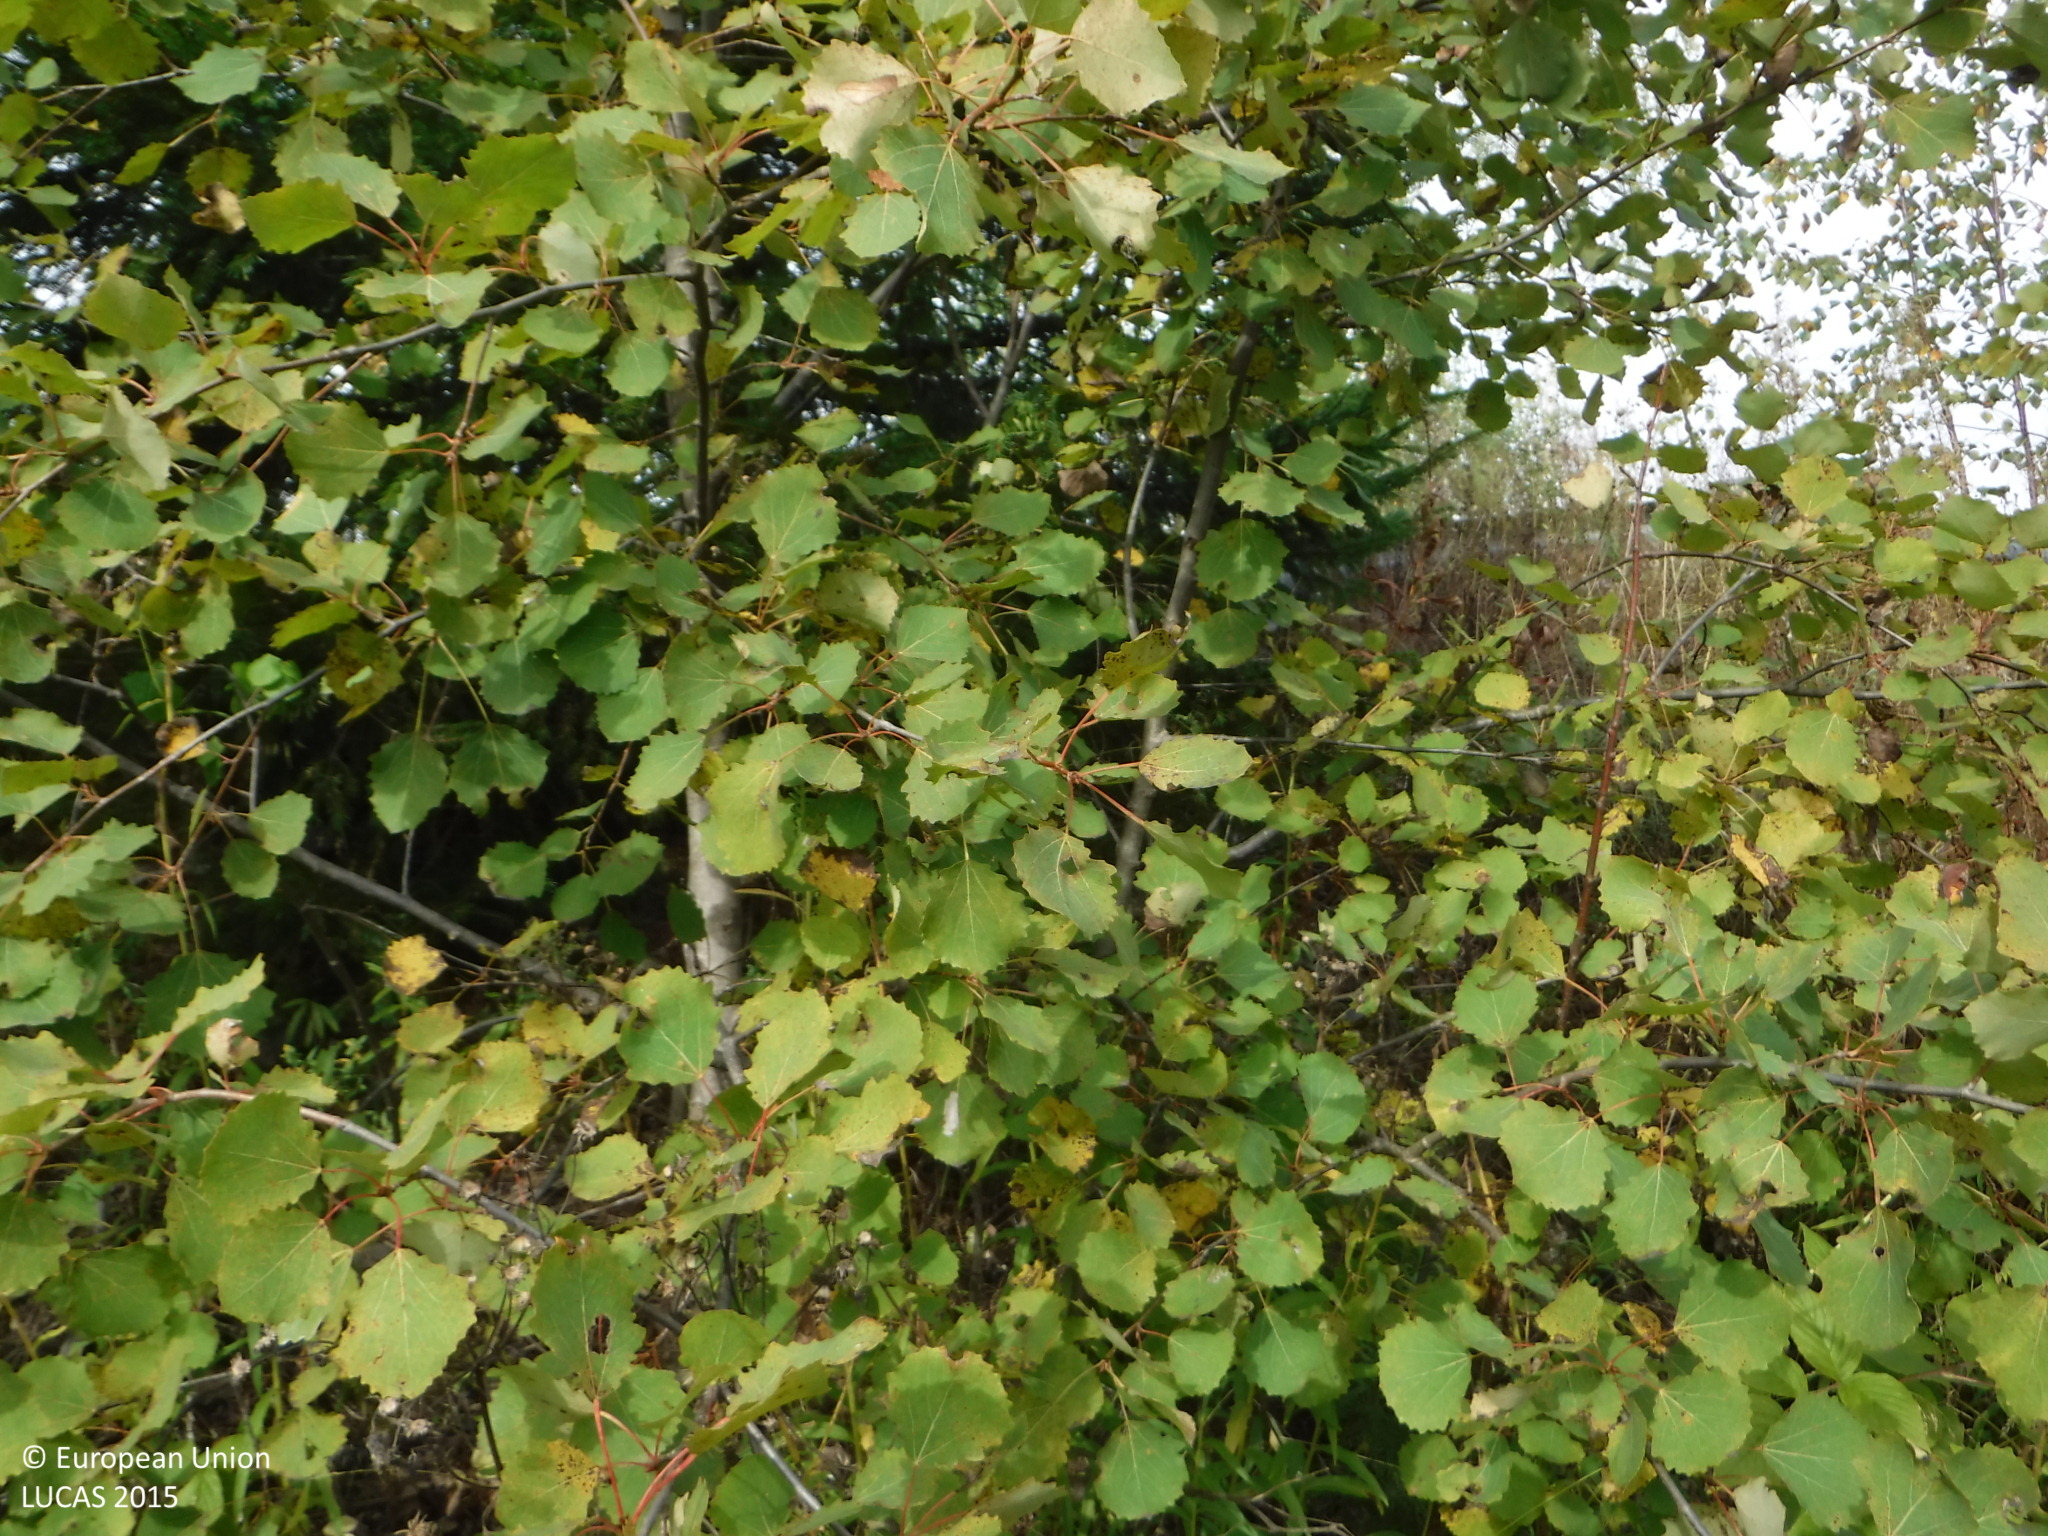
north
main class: Woodland
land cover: Broadleaved woodland
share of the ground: > 75 %
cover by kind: broadleaved forest trees 75 %, shrubs 20 %, herbaceous plants 5 %
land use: Semi-natural and natural areas not in use
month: September
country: FI
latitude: 61.4213
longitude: 23.0209
